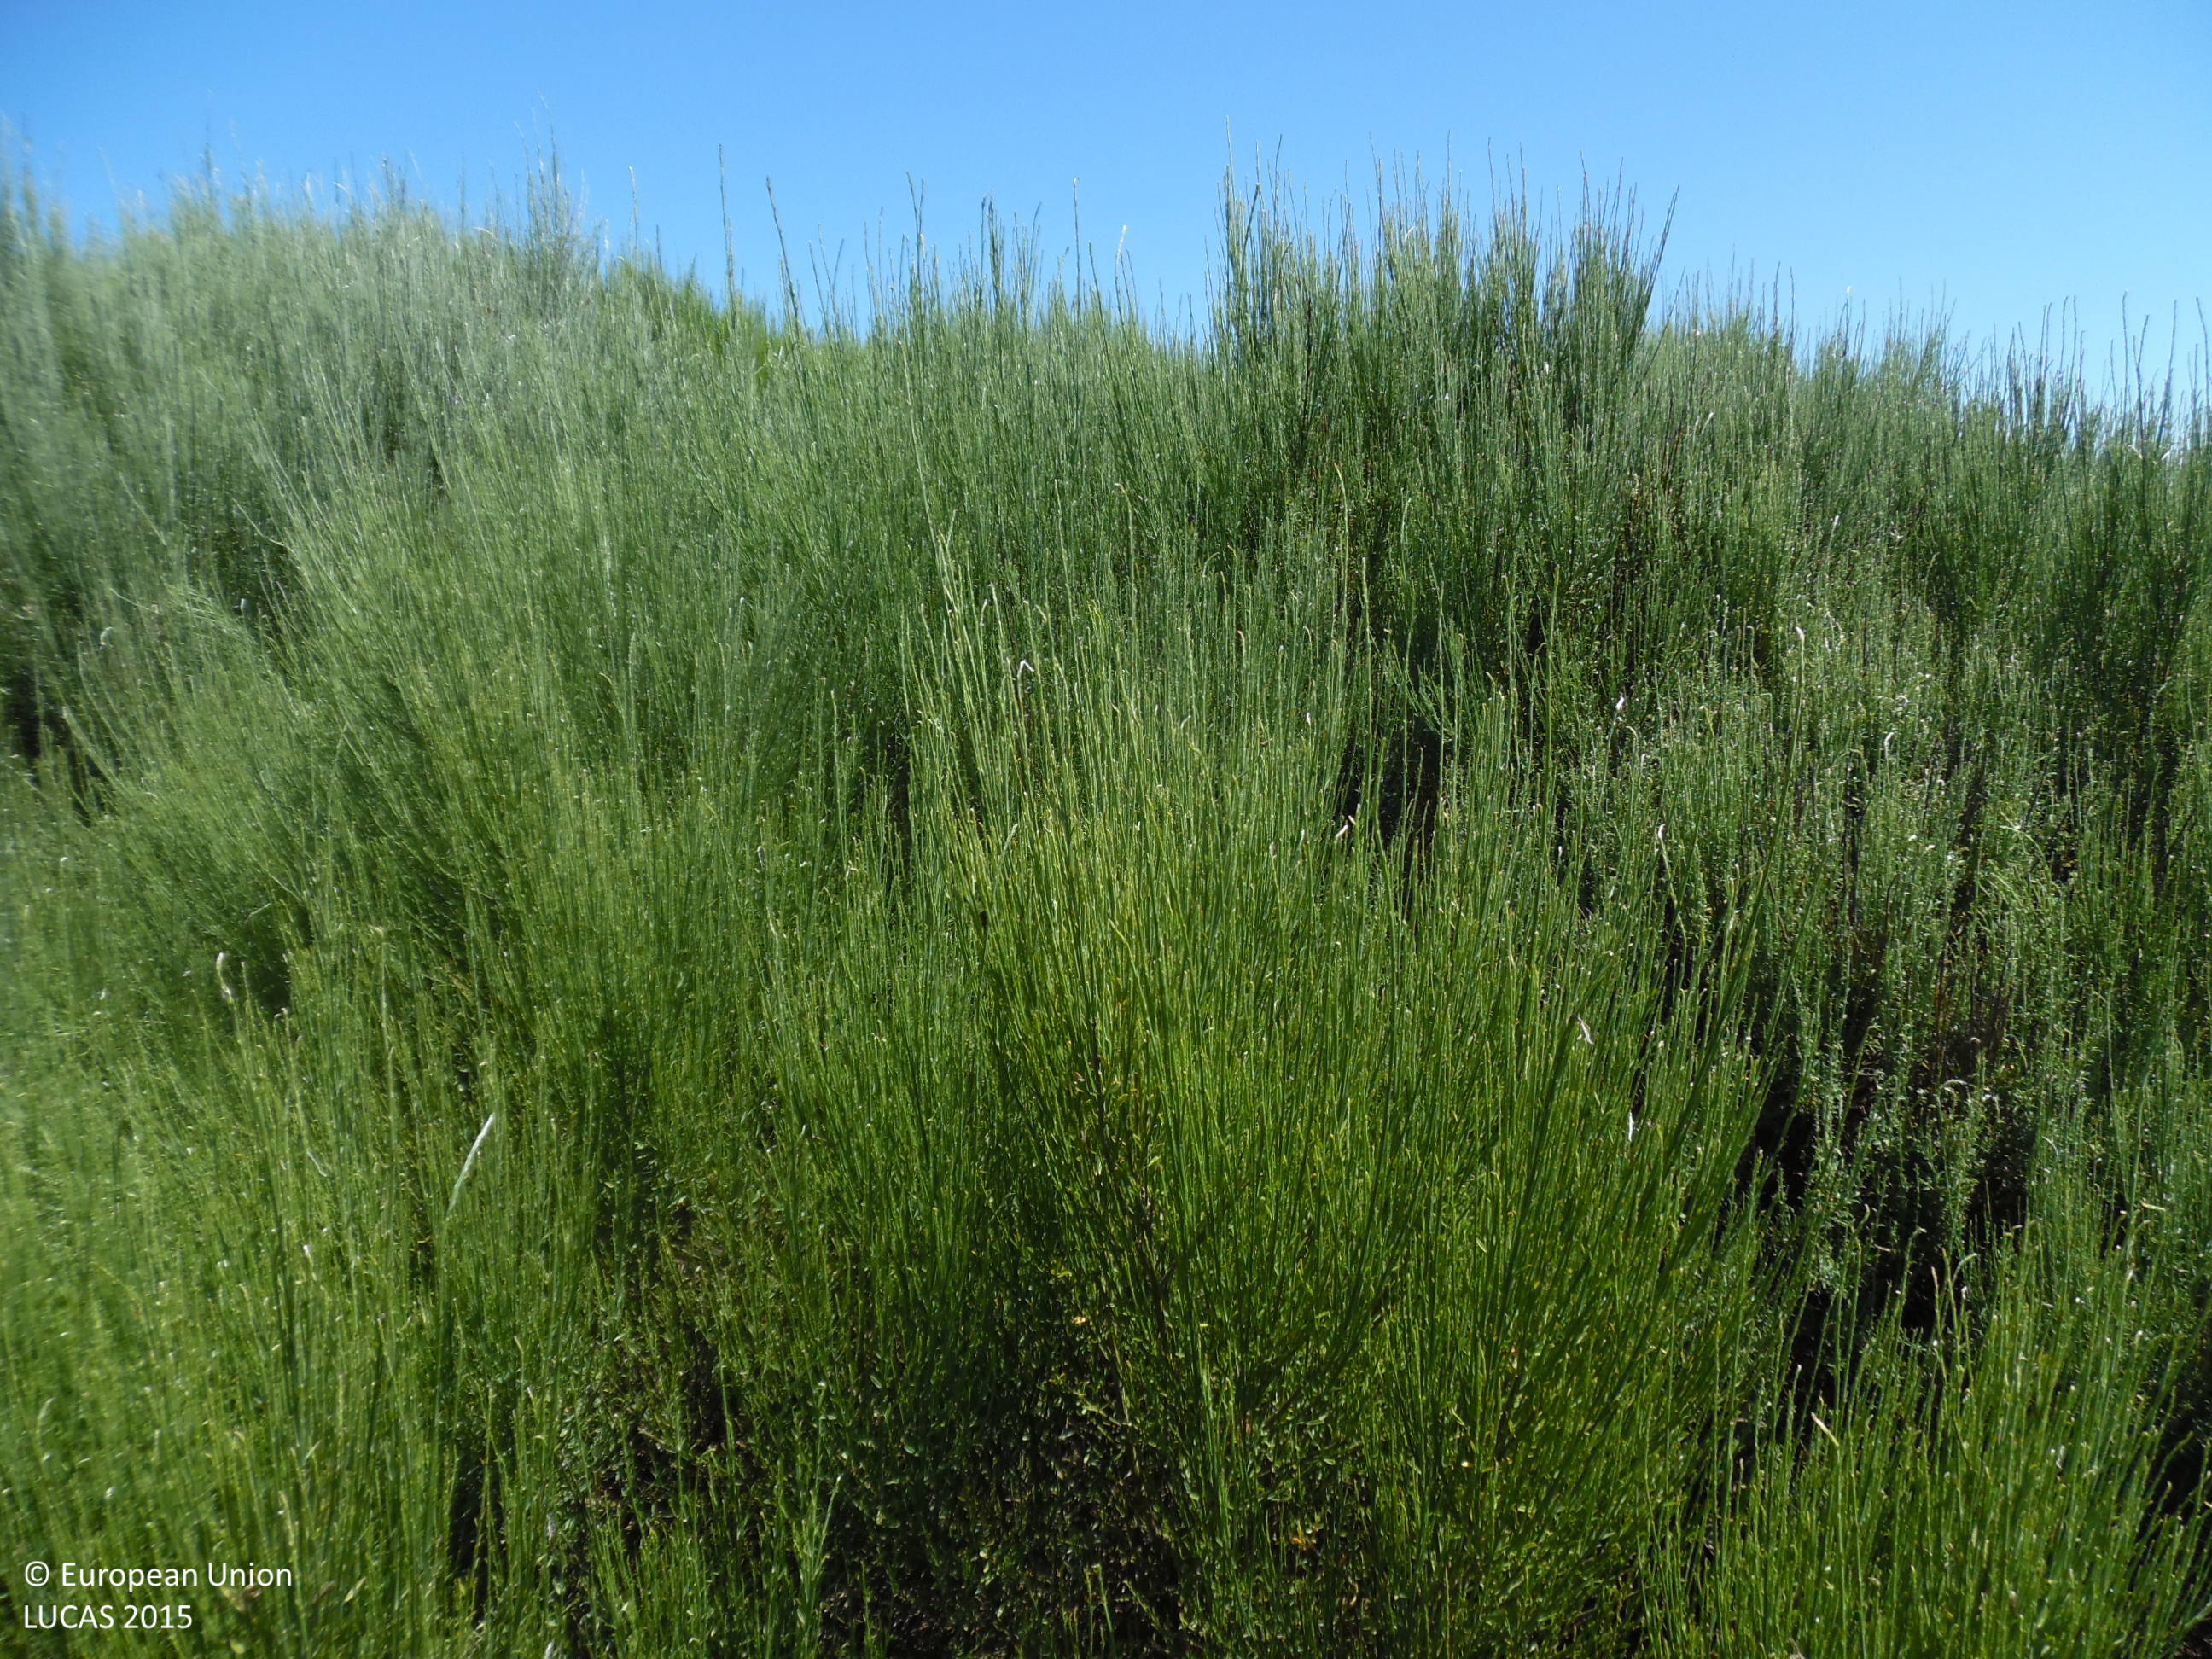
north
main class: Shrubland
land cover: Shrubland without tree cover
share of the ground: > 75 %
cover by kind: shrubs 100 %
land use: Abandoned areas
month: June
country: ES
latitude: 42.6086
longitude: -6.8634
